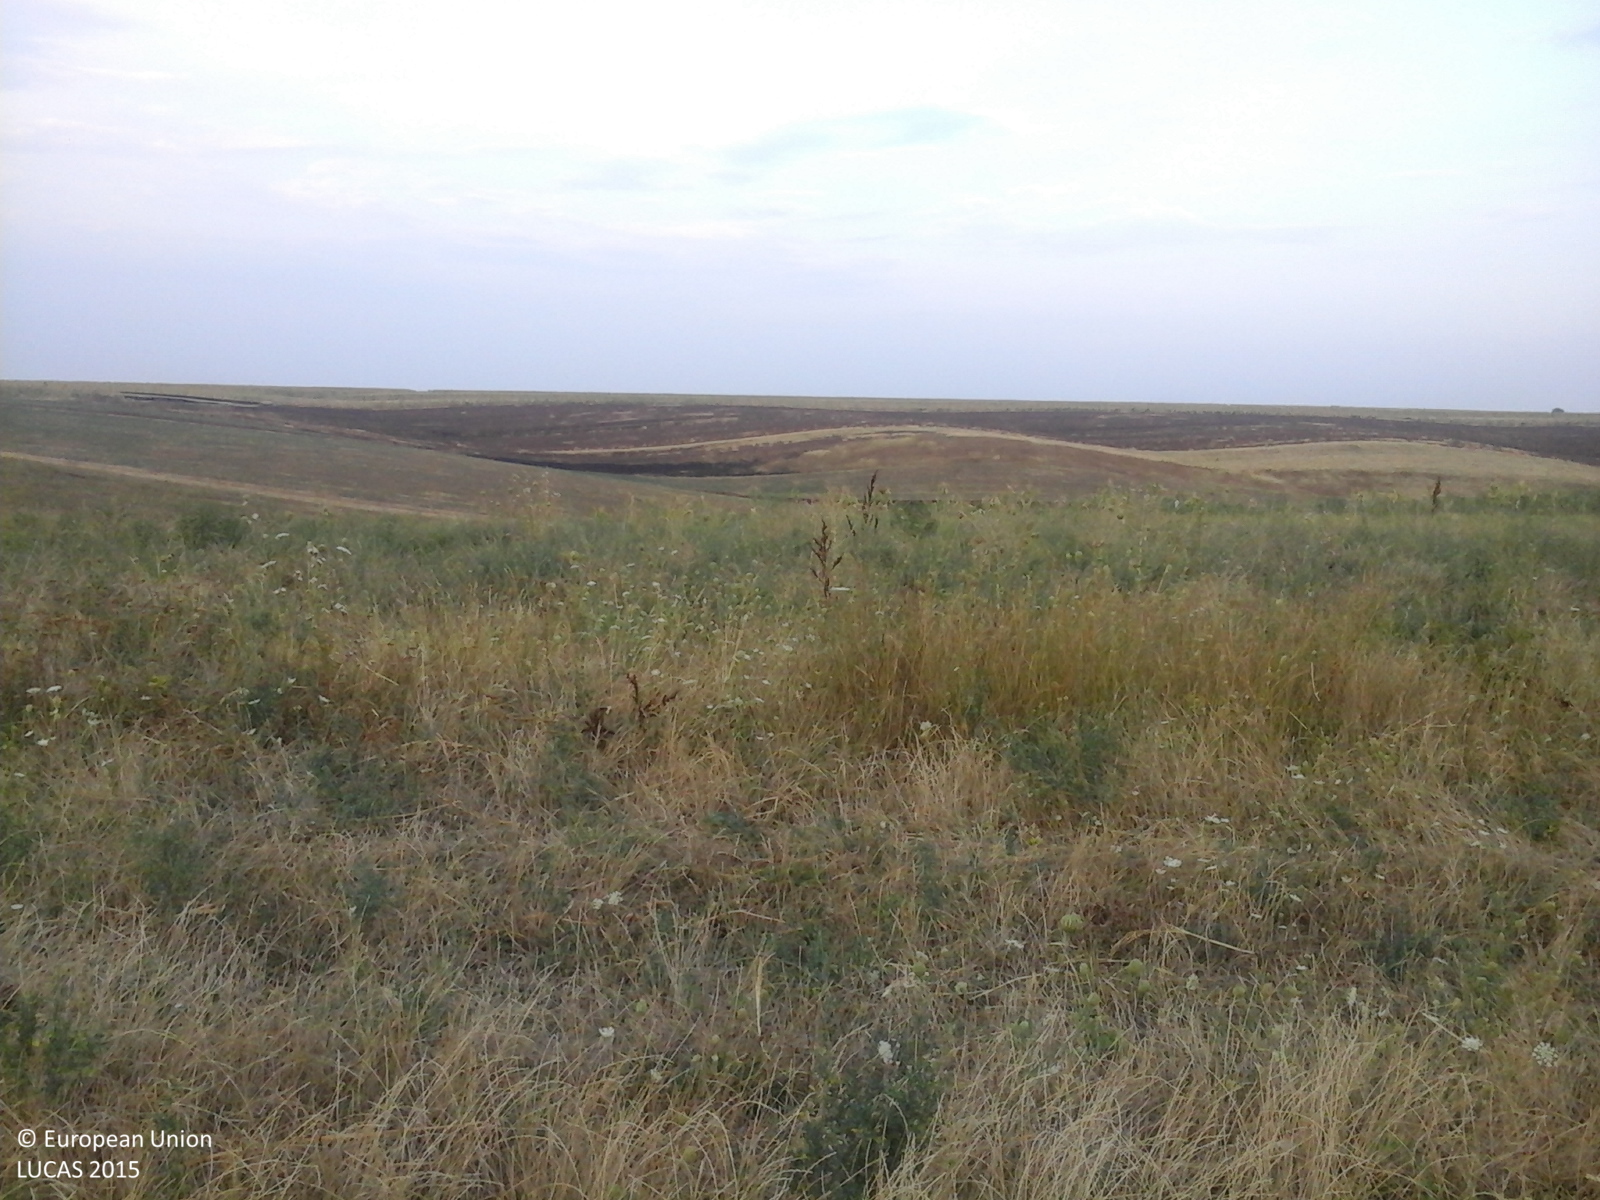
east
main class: Cropland
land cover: Lucerne
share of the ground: > 75 %
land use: Agriculture (excluding fallow land and kitchen gardens)
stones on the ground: < 10 %
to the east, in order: Lucerne; Shruby margins; Tracks; Spontaneously vegetated surfaces; Grassland without tree/shrub cover; Maize; Lucerne; Tracks; Lucerne; Common wheat; Lucerne; Spontaneously vegetated surfaces
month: August
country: RO
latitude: 44.3194
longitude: 23.0979
